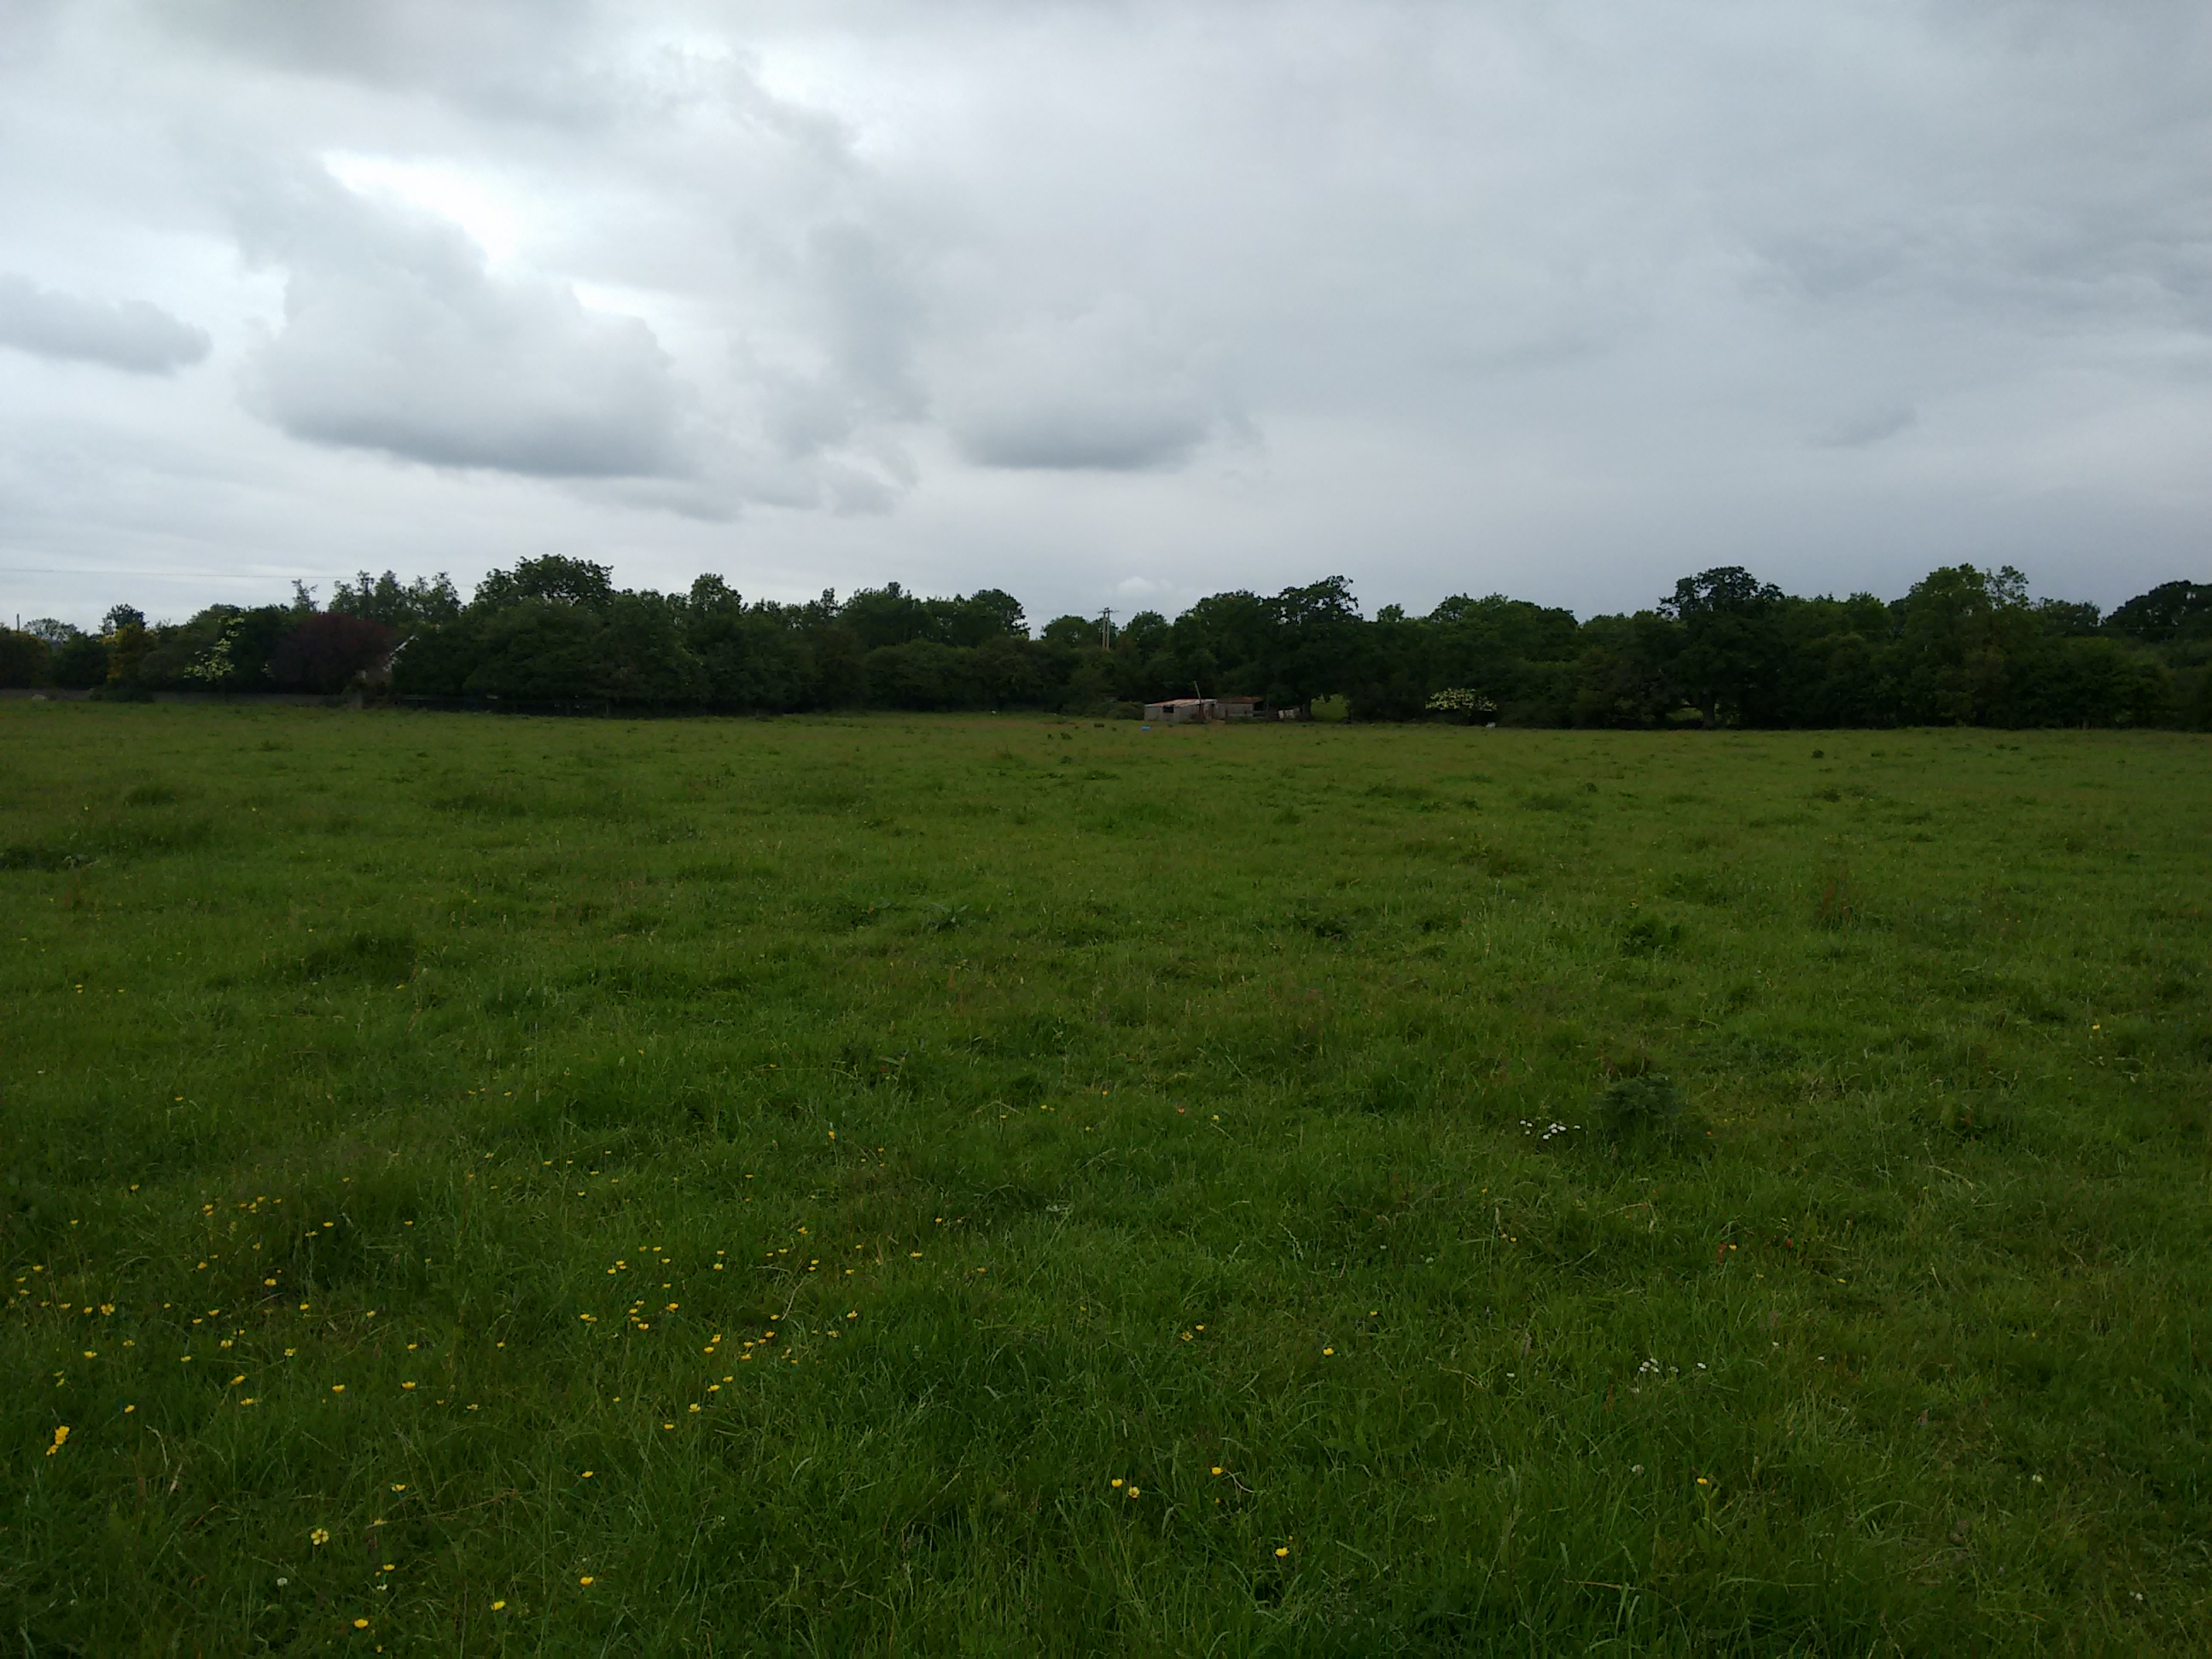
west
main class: Grassland
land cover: Grassland without tree/shrub cover
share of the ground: > 75 %
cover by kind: herbaceous plants 95 %, shrubs 5 %
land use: Agriculture (excluding fallow land and kitchen gardens)
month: June
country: IE
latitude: 53.4025
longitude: -7.8740
